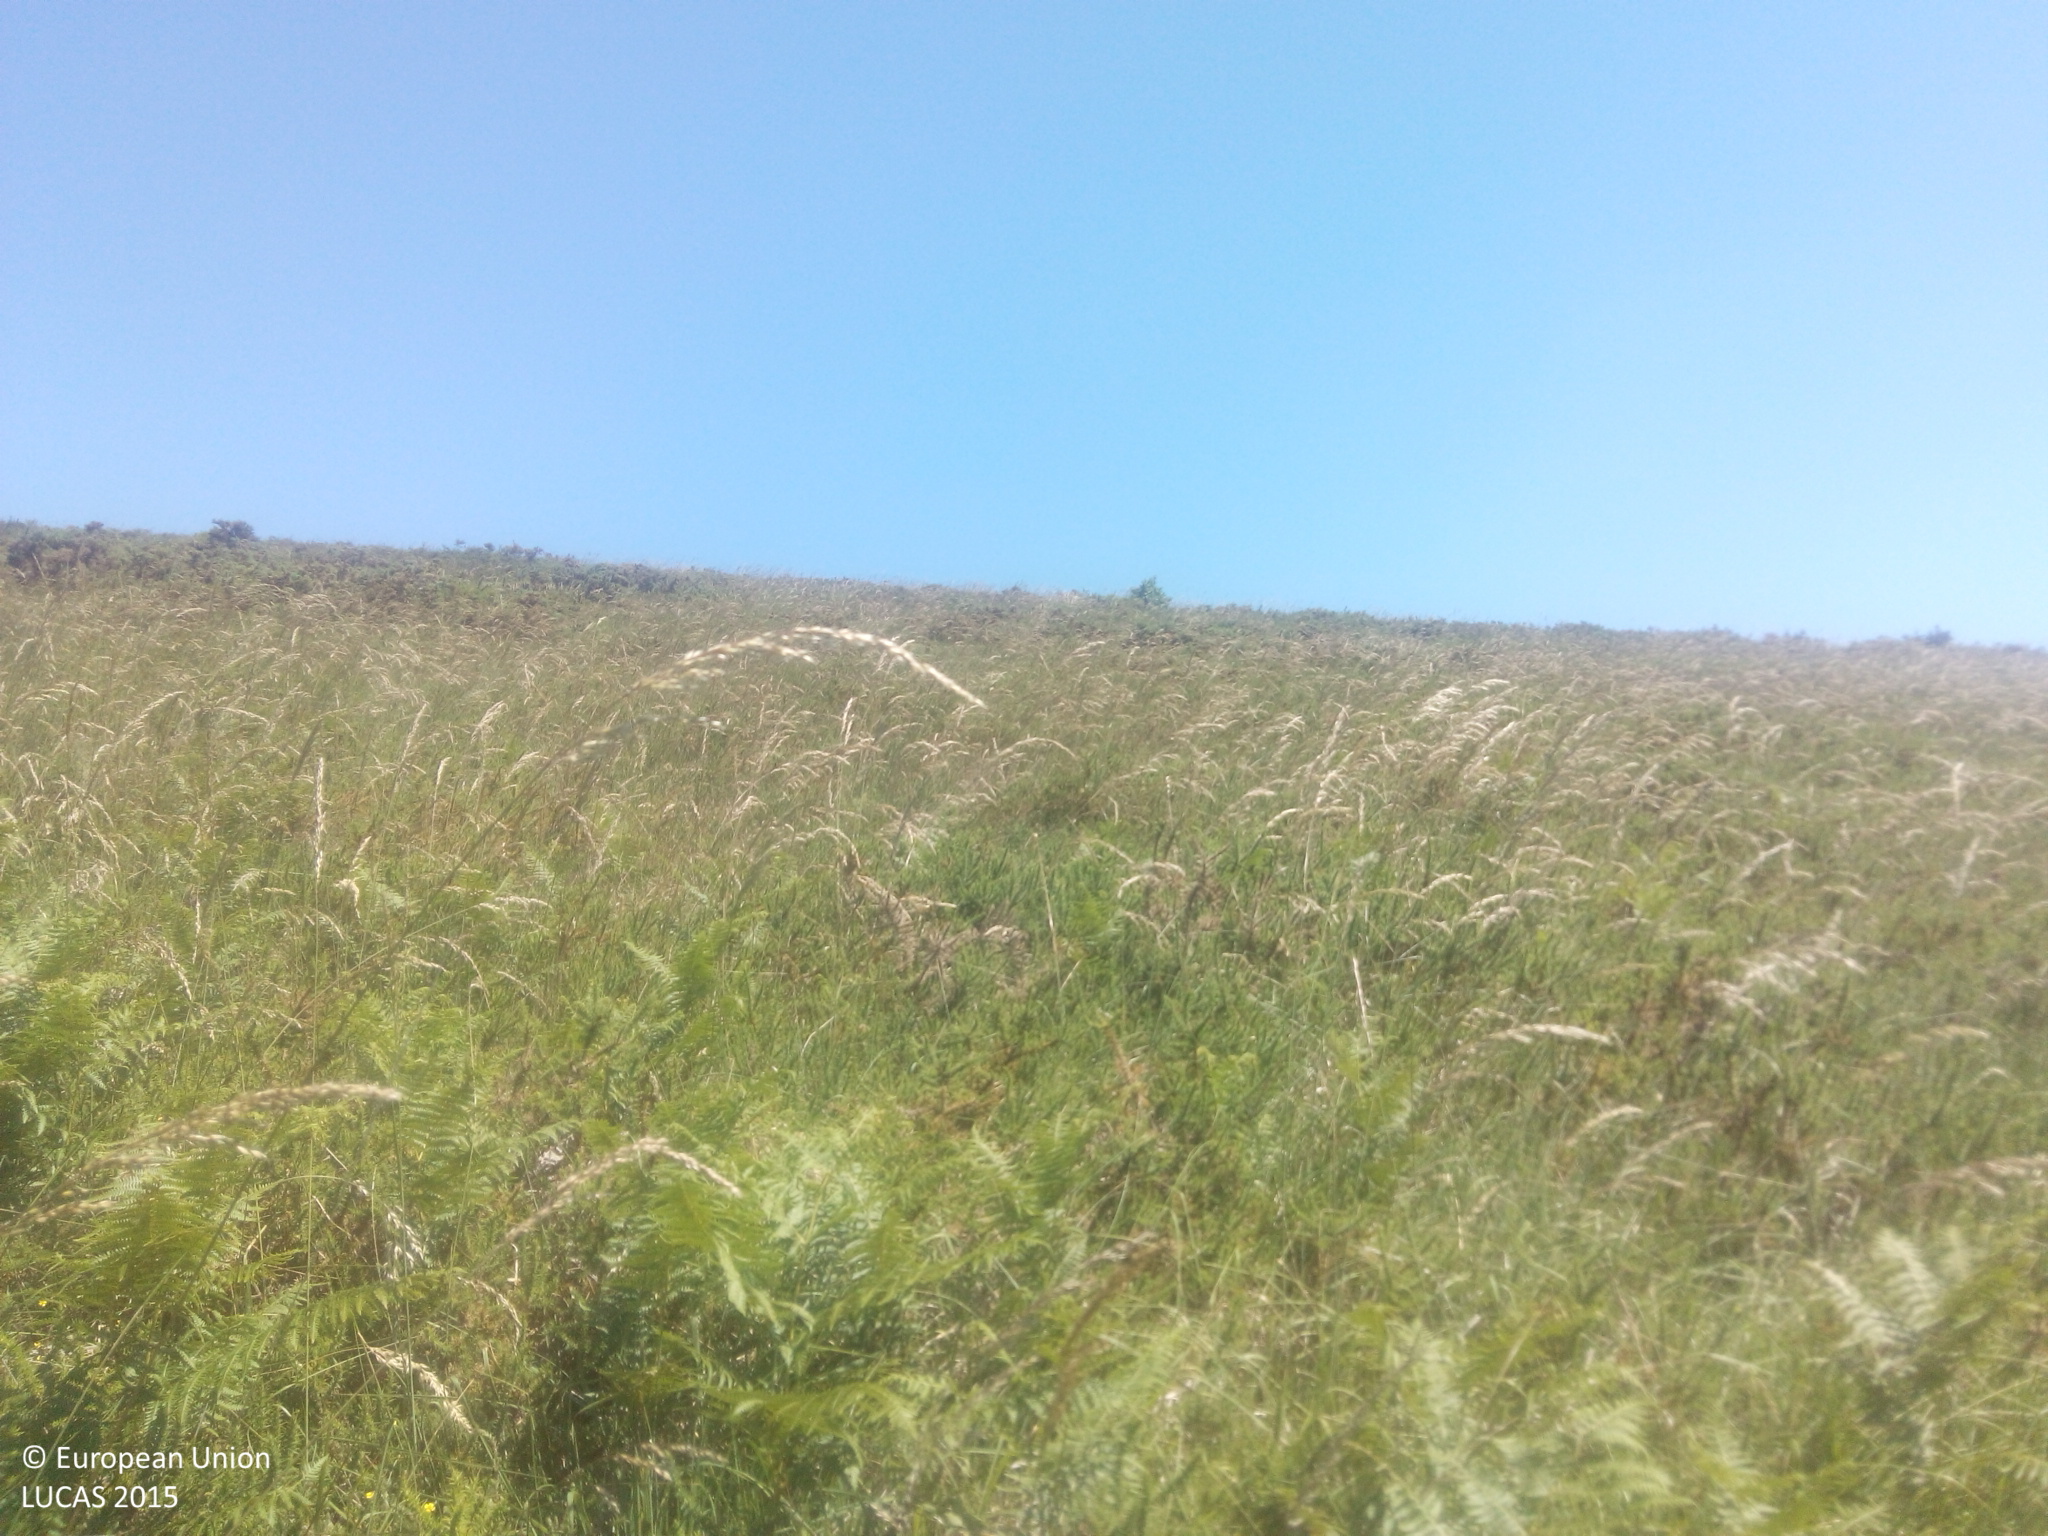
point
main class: Shrubland
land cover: Shrubland without tree cover
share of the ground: > 75 %
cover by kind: shrubs 100 %
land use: Semi-natural and natural areas not in use
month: June
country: ES
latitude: 42.4575
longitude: -8.3455
